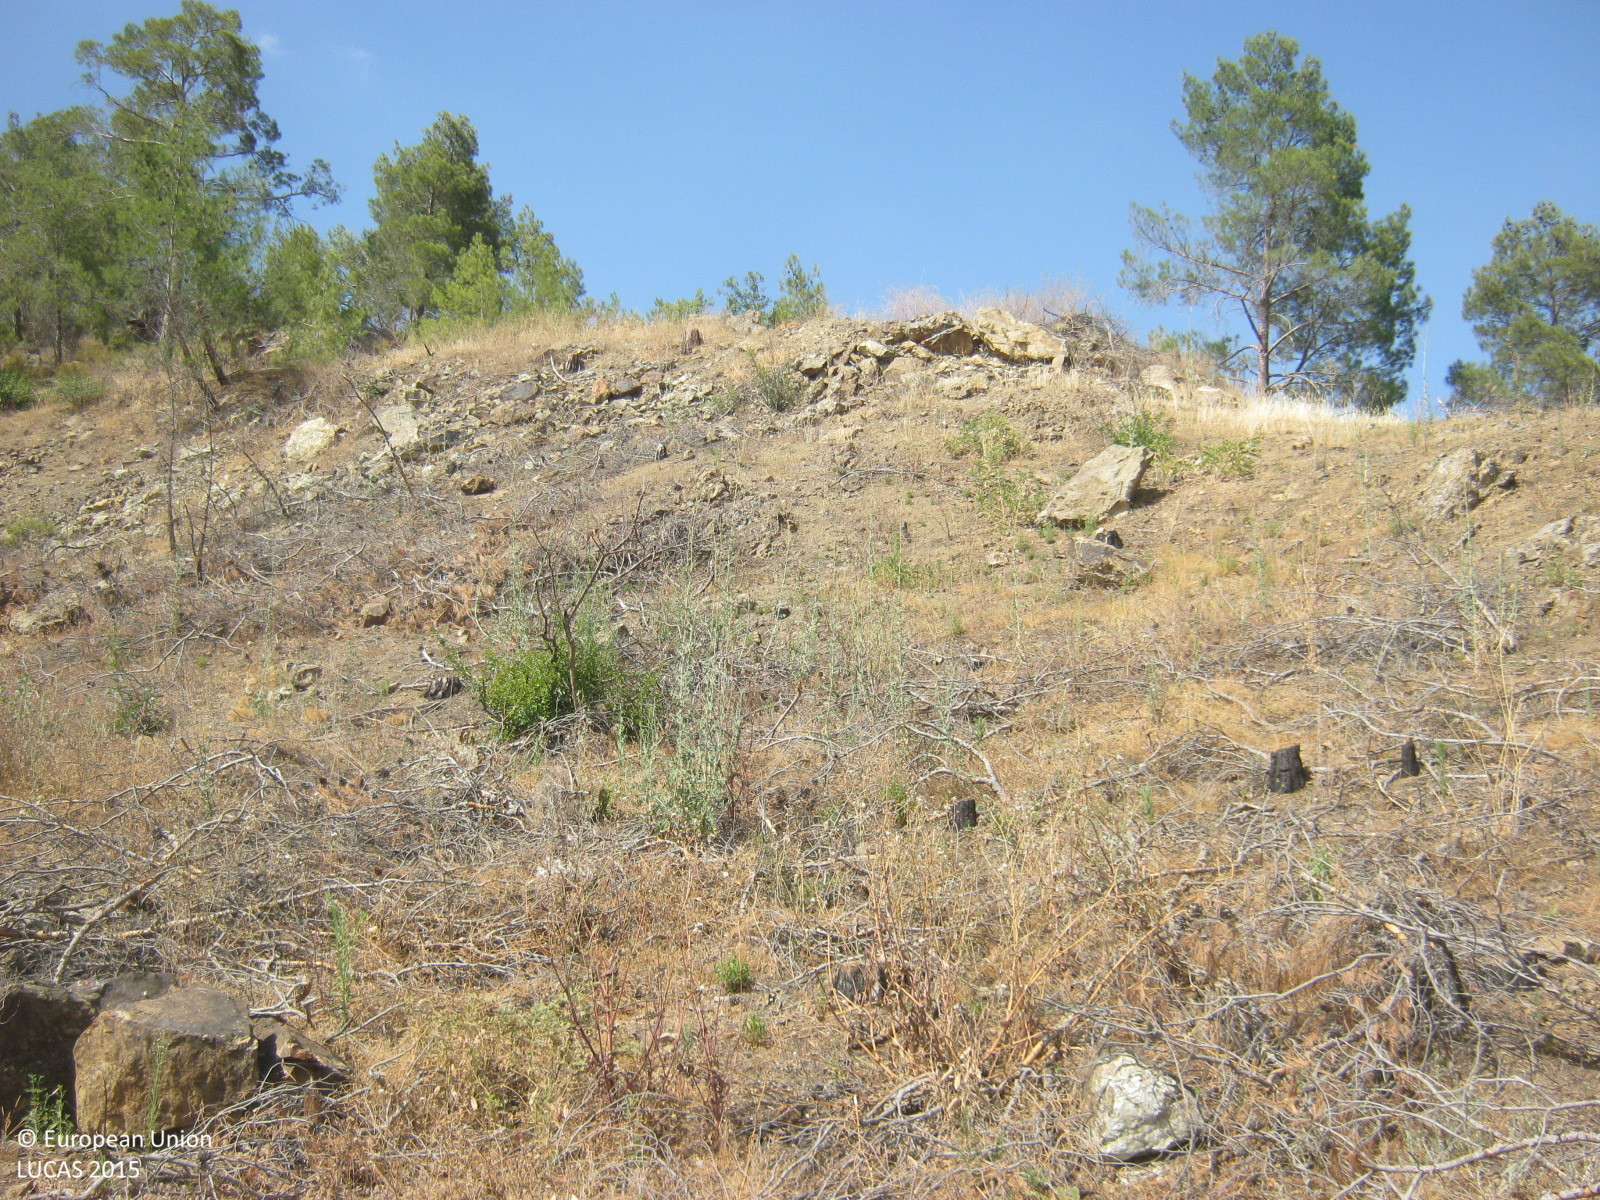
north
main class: Grassland
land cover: Grassland without tree/shrub cover
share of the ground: 10 - 25 %
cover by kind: unconsolidated bare surface 80 %, herbaceous plants 15 %, shrubs 5 %
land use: Forestry
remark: Burnt area
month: June
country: CY
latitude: 34.9806
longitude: 33.1500
